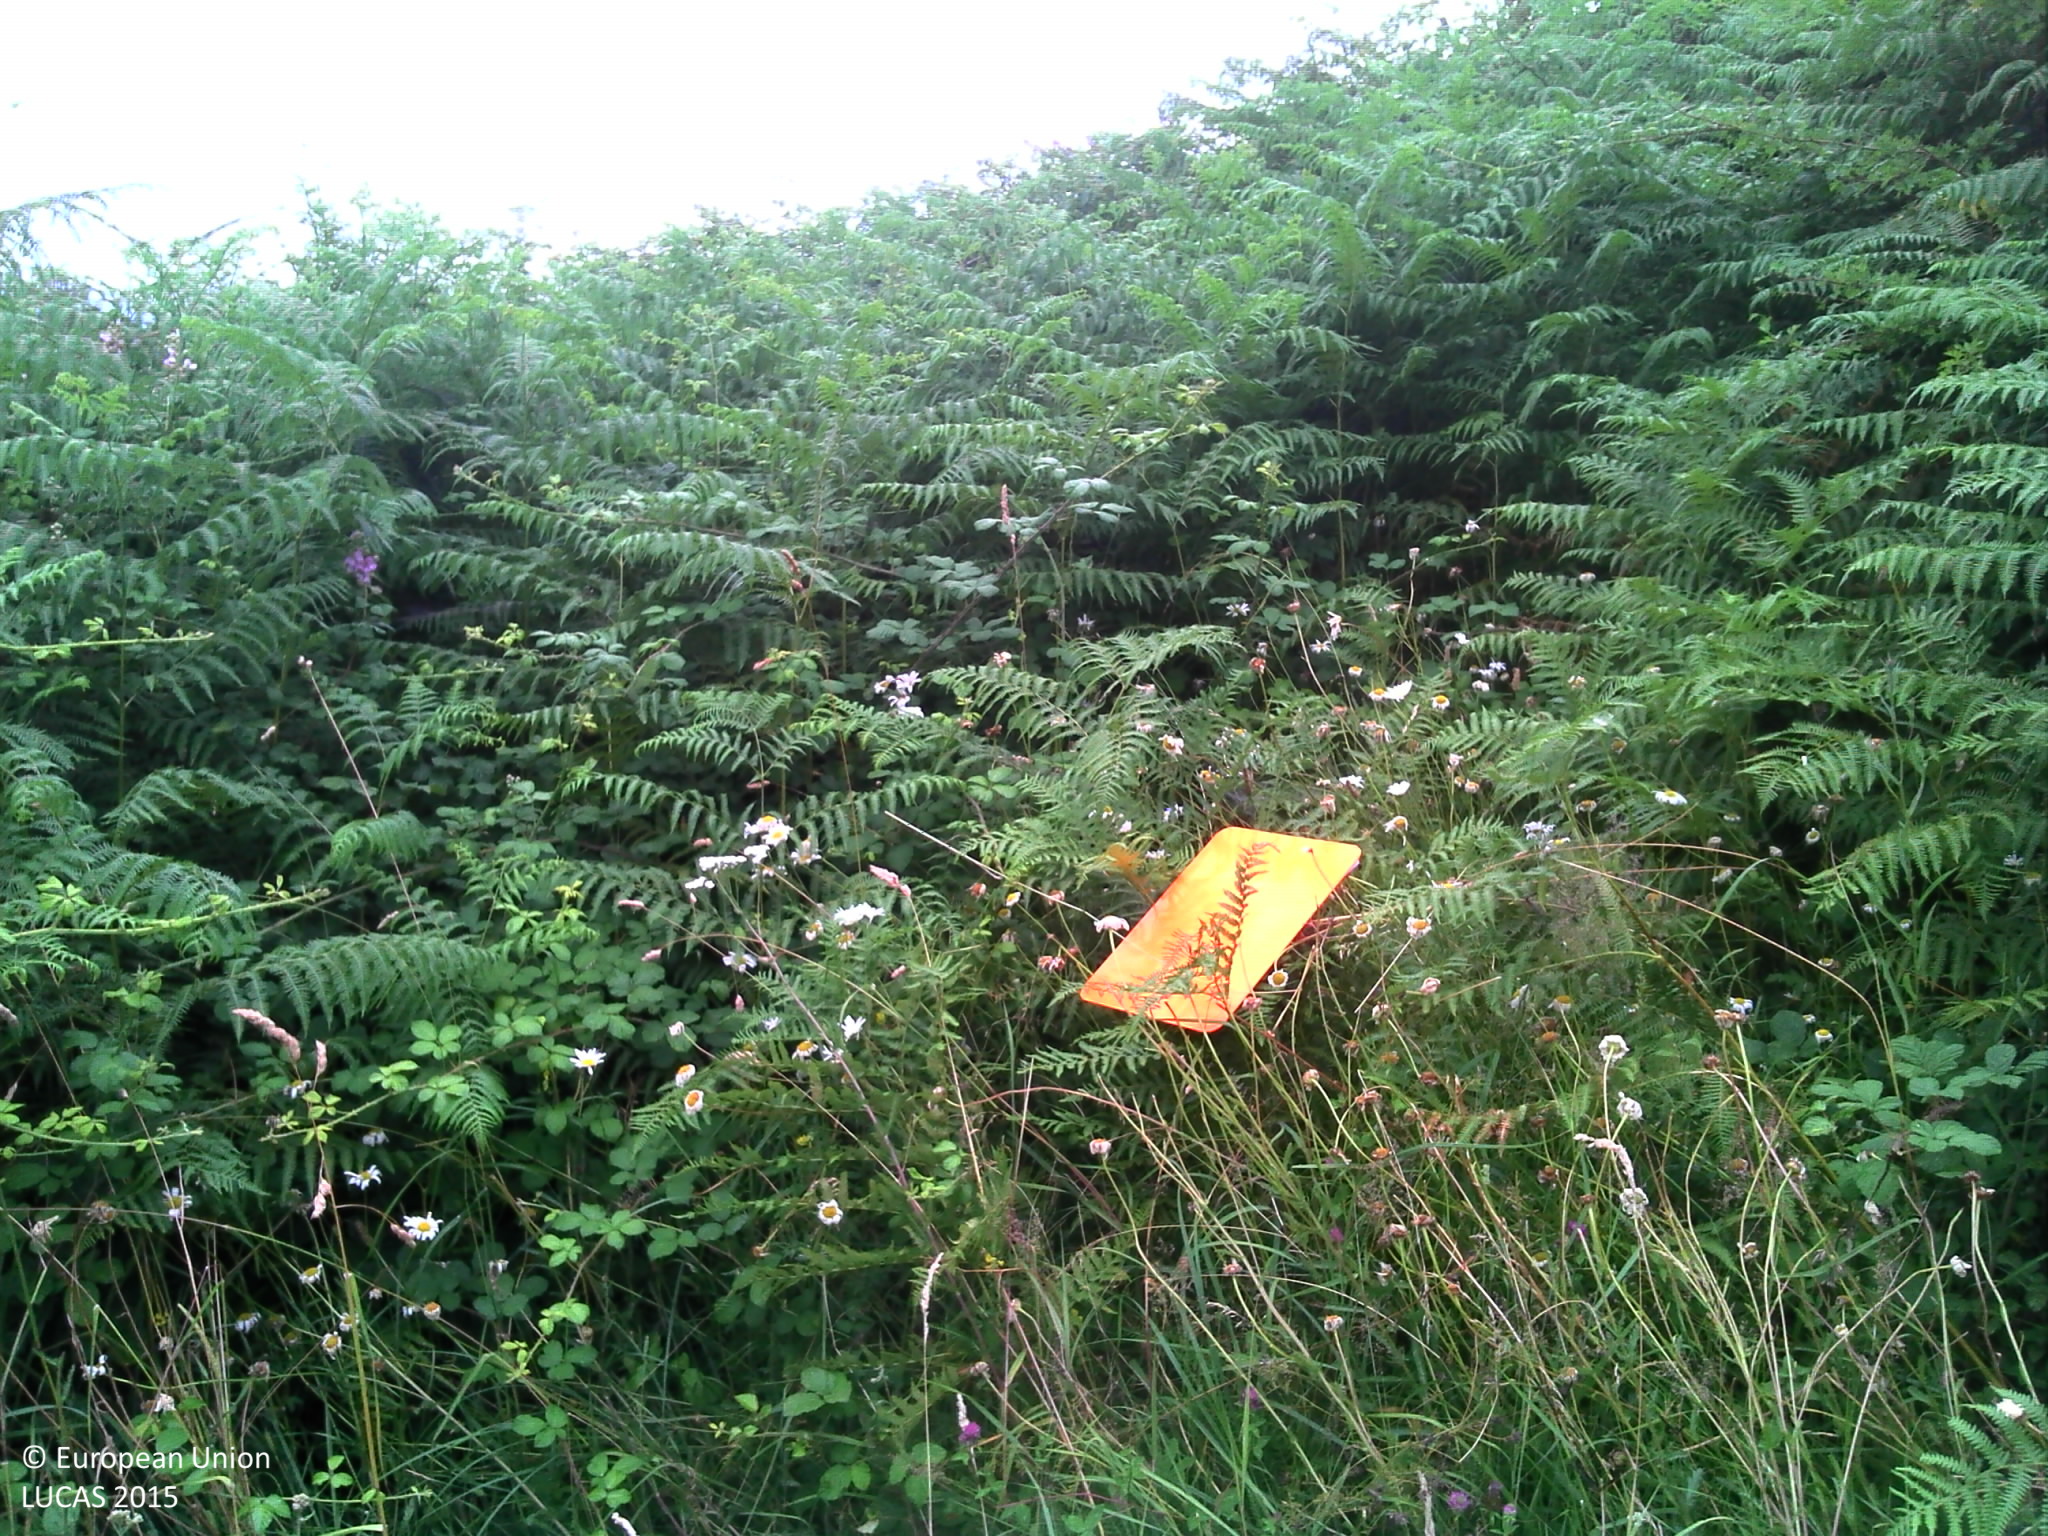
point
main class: Grassland
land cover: Spontaneously vegetated surfaces
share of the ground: > 75 %
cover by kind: herbaceous plants 95 %, shrubs 5 %
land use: Agriculture (excluding fallow land and kitchen gardens)
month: July
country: FR
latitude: 48.9701
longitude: 0.0660
